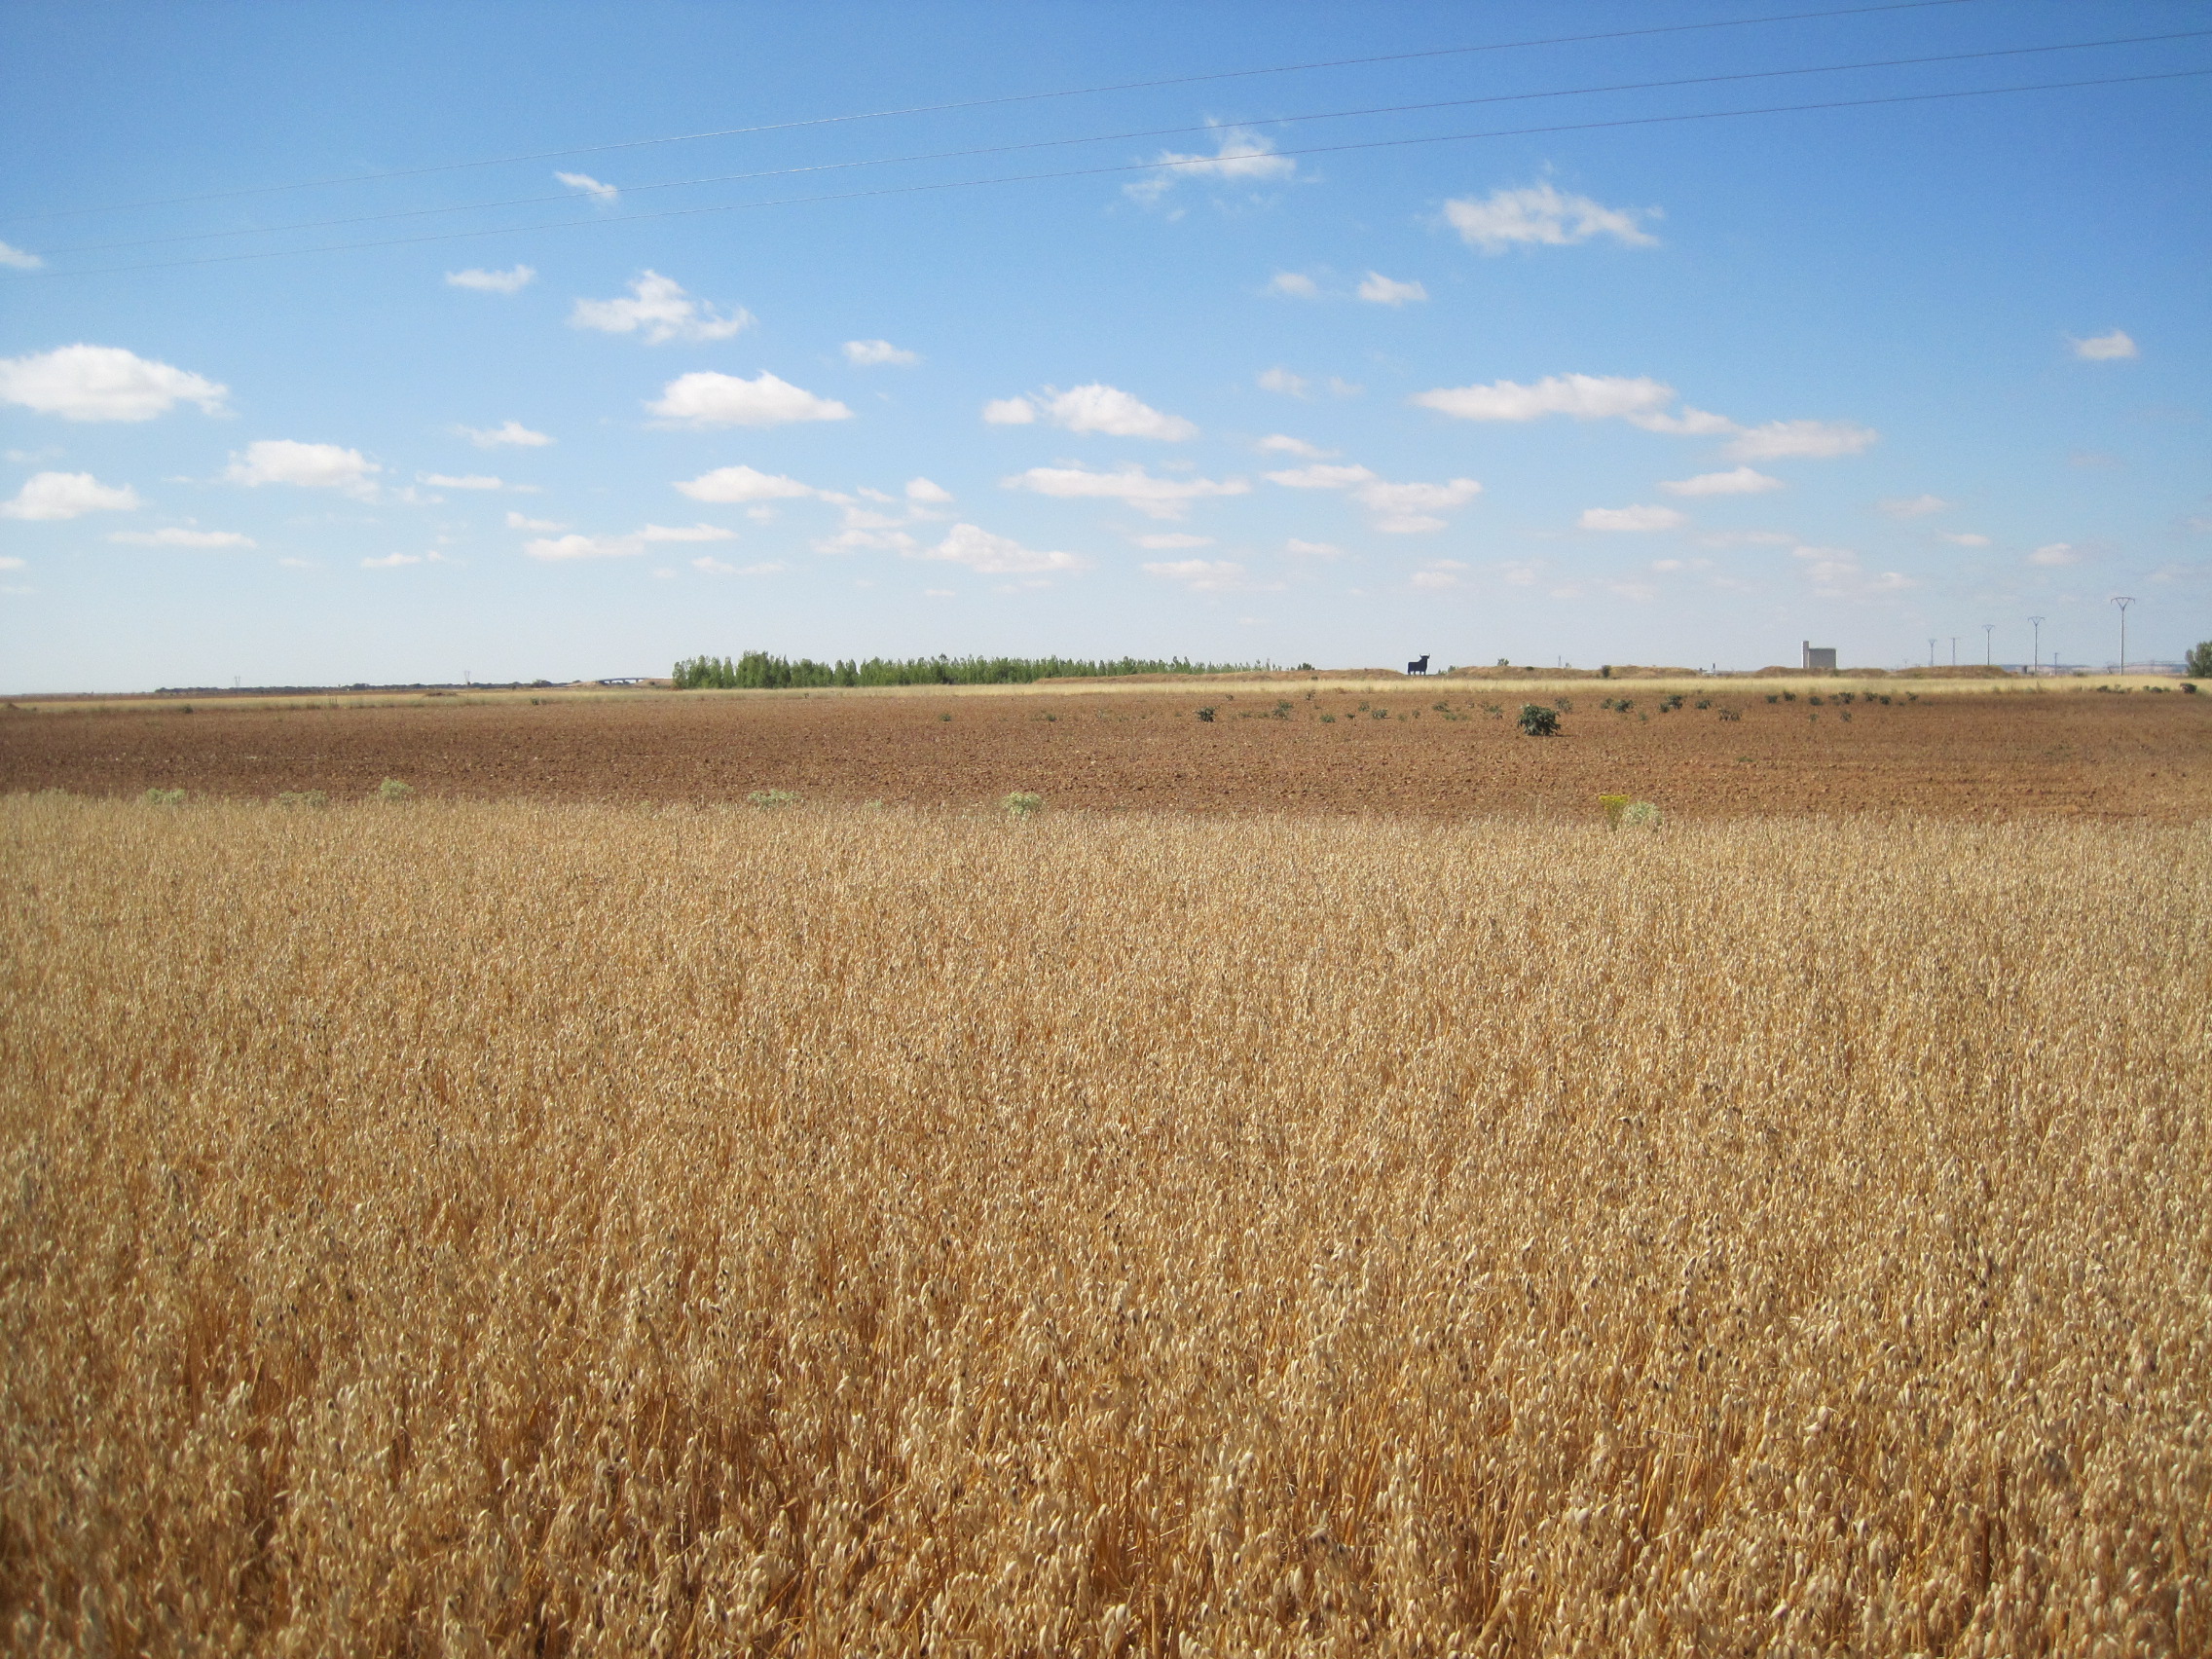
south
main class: Cropland
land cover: Oats
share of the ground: > 75 %
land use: Agriculture (excluding fallow land and kitchen gardens)
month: July
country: ES
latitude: 41.9623
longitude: -5.6432
